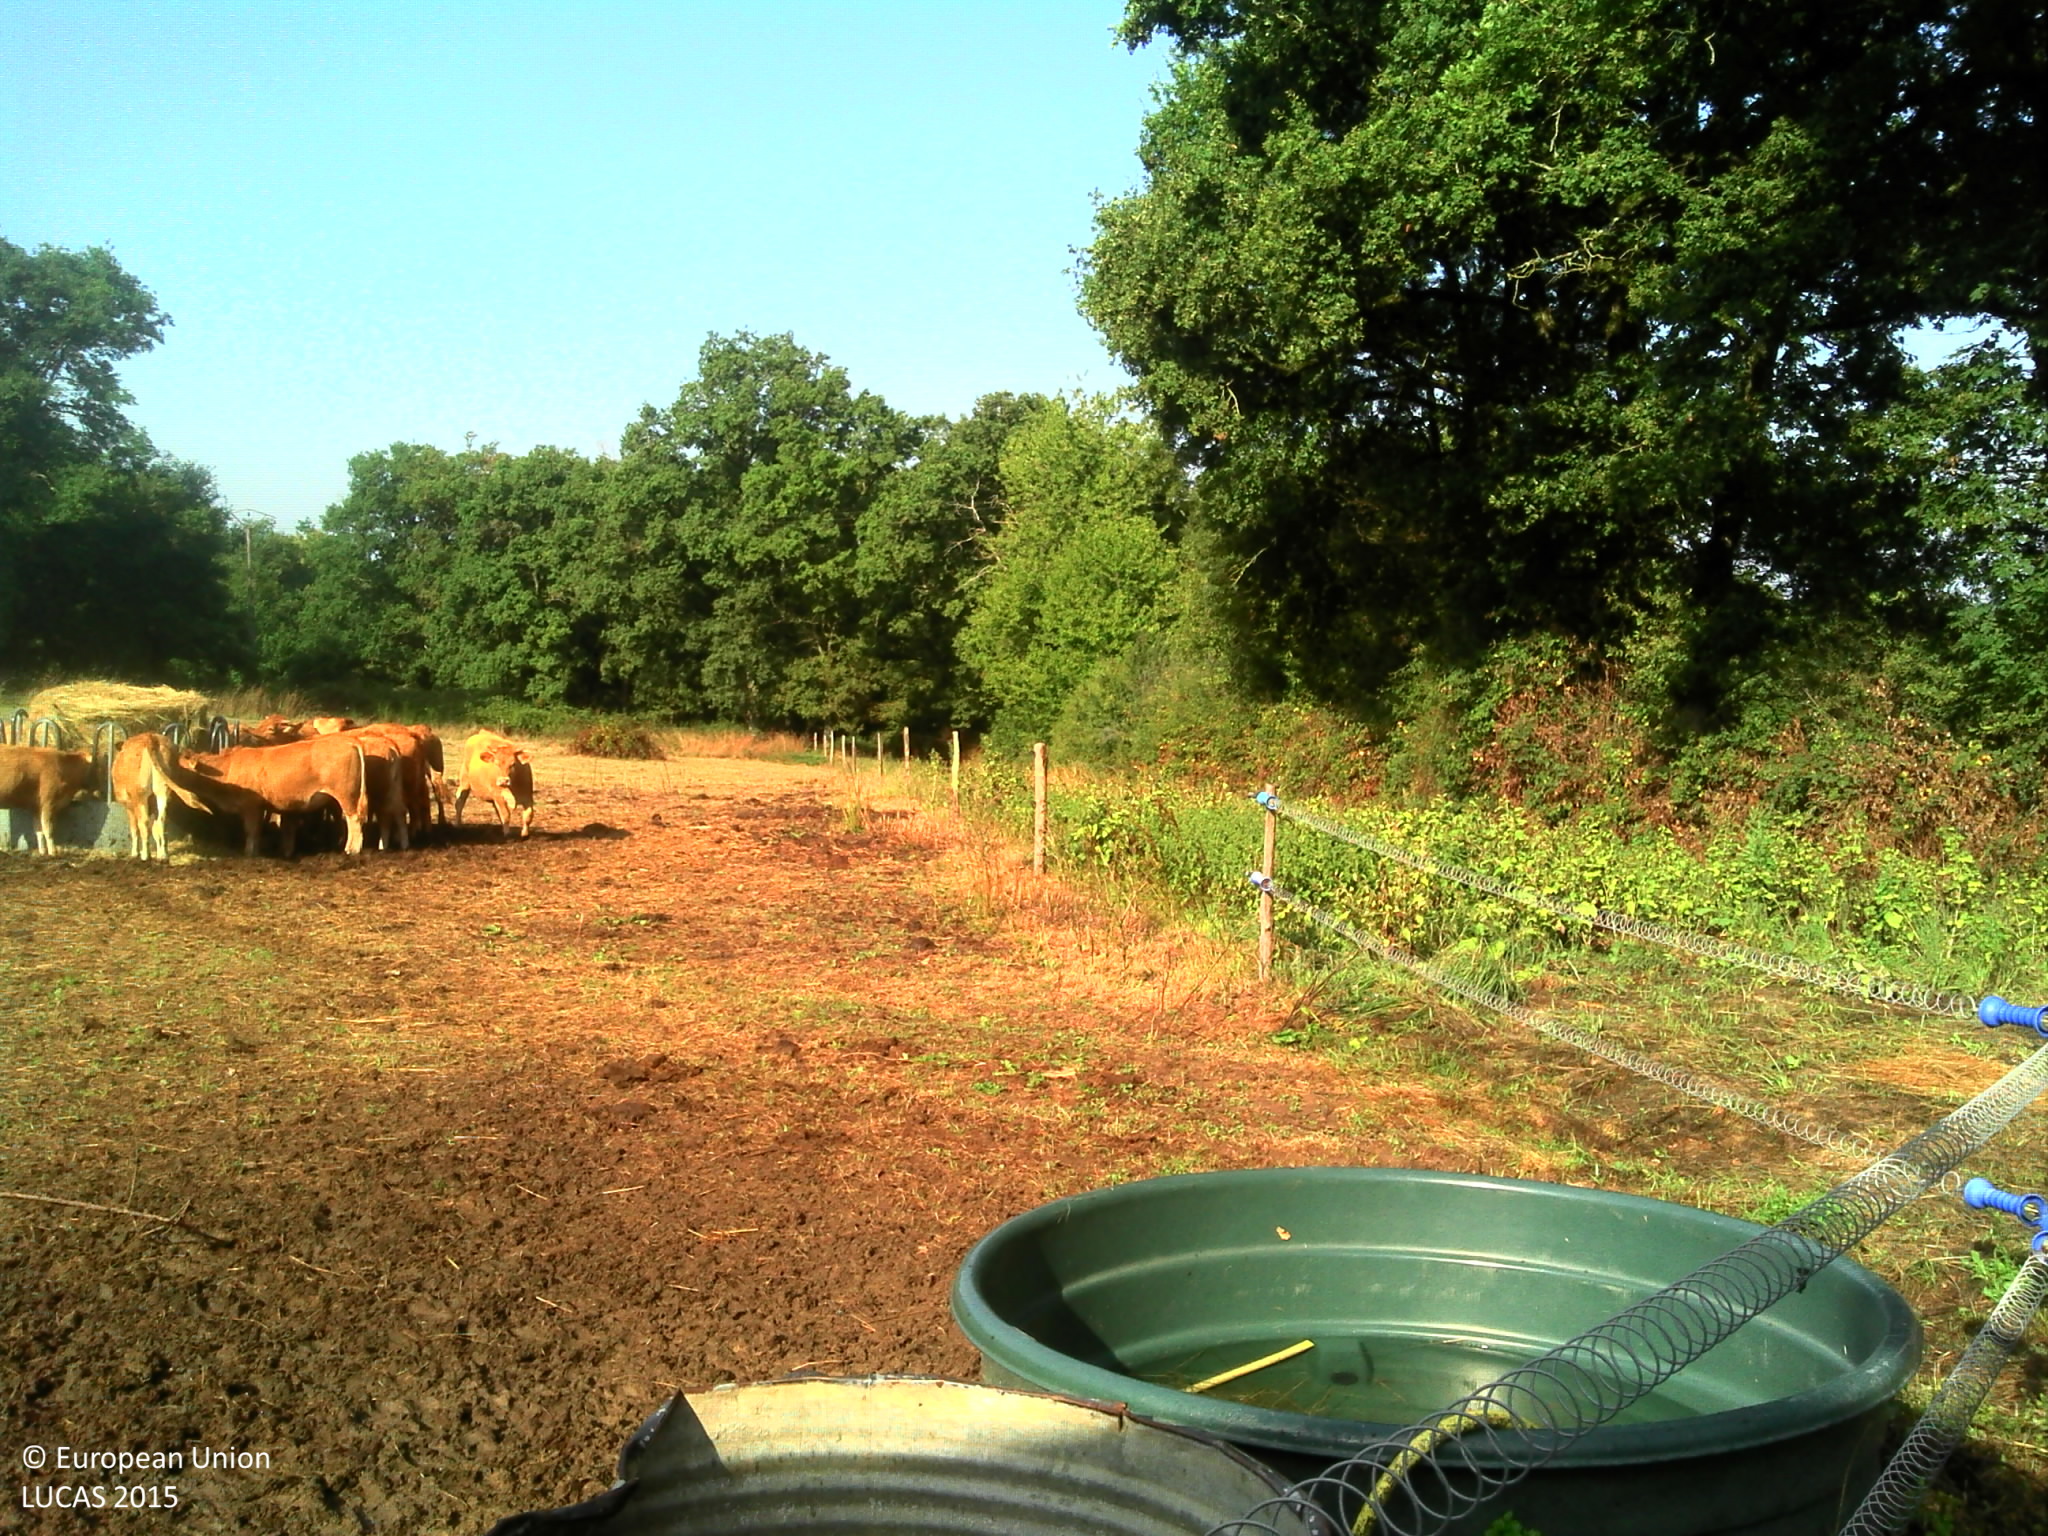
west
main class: Grassland
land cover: Grassland without tree/shrub cover
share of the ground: > 75 %
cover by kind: herbaceous plants 100 %
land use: Agriculture (excluding fallow land and kitchen gardens)
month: August
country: FR
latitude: 46.1893
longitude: 1.0087
